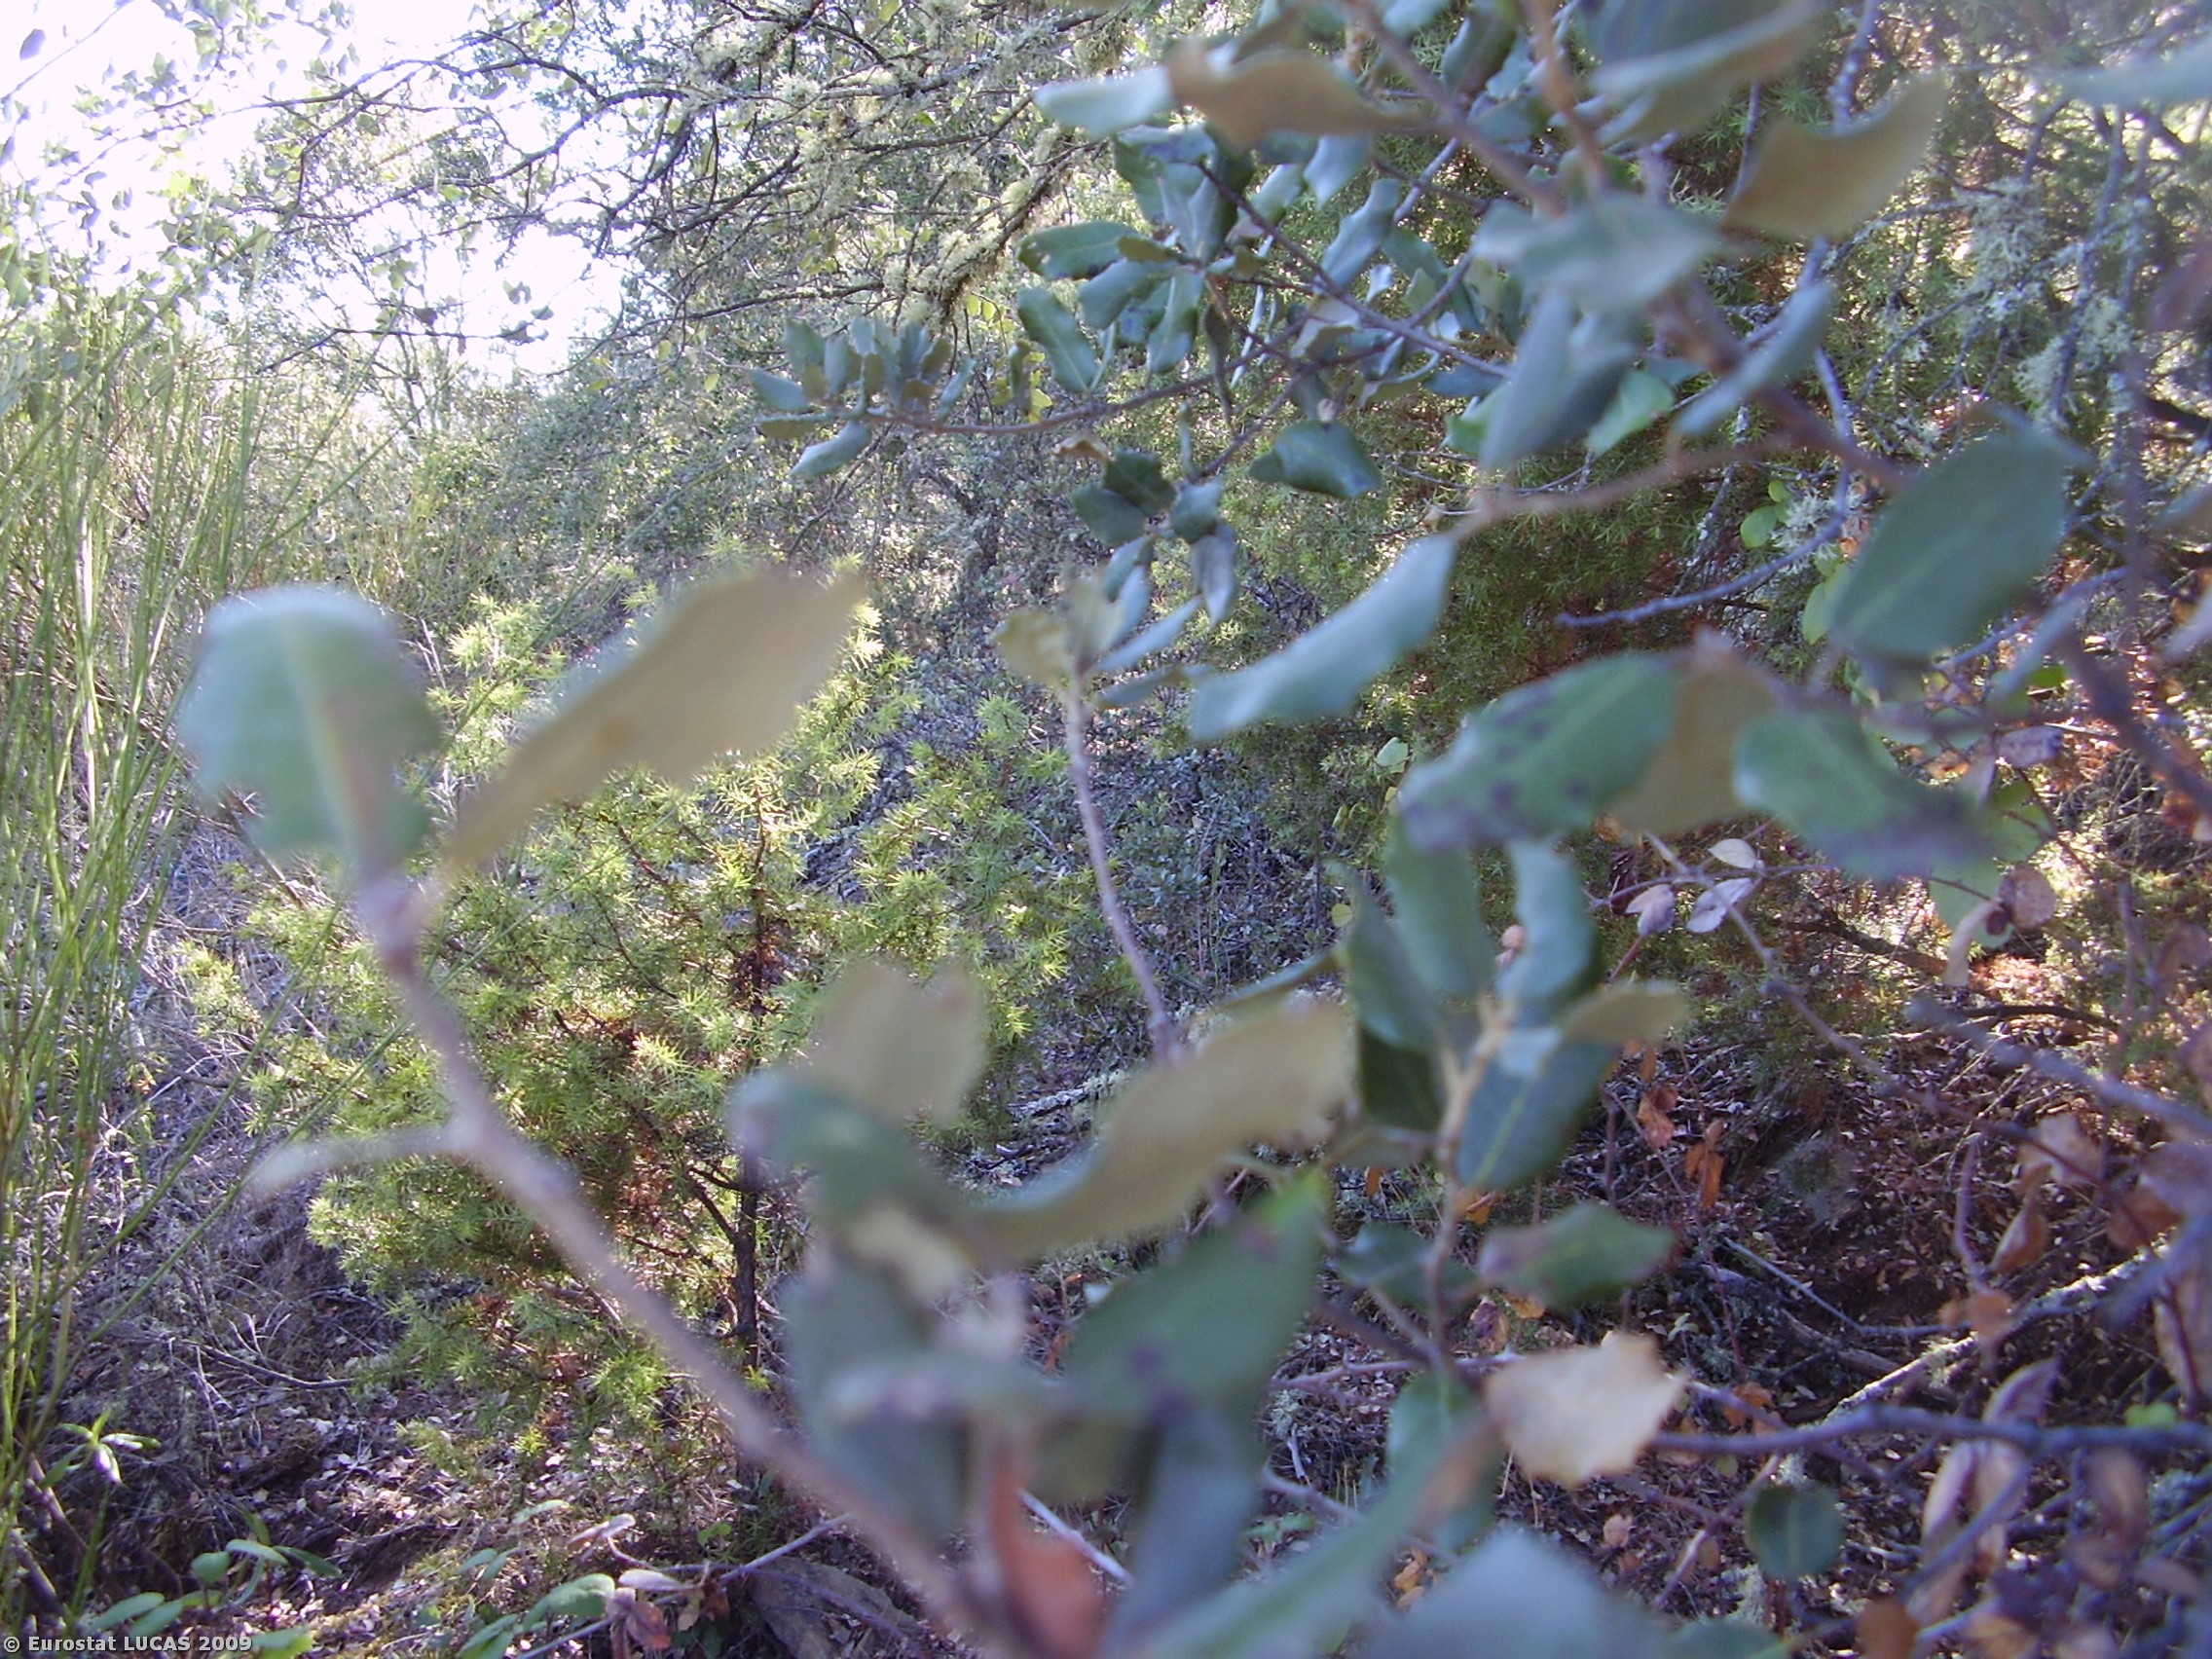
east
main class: Woodland
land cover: Broadleaved woodland
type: broadleaved evergreen forest
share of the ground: 10 - 25 %
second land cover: Shrubland with sparse tree cover
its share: > 75 %
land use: Forestry
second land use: Fallow land
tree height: > 5 m
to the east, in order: Broadleaved woodland; Shrubland with sparse tree cover; Broadleaved woodland; Dry stone walls; Broadleaved woodland; Dry stone walls; Broadleaved woodland; Grass margins; Paved roads, cycling and walking lanes; Grass margins; Broadleaved woodland; Spontaneously vegetated surfaces; Broadleaved woodland
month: August
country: PT
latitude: 41.3958
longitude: -6.7436
